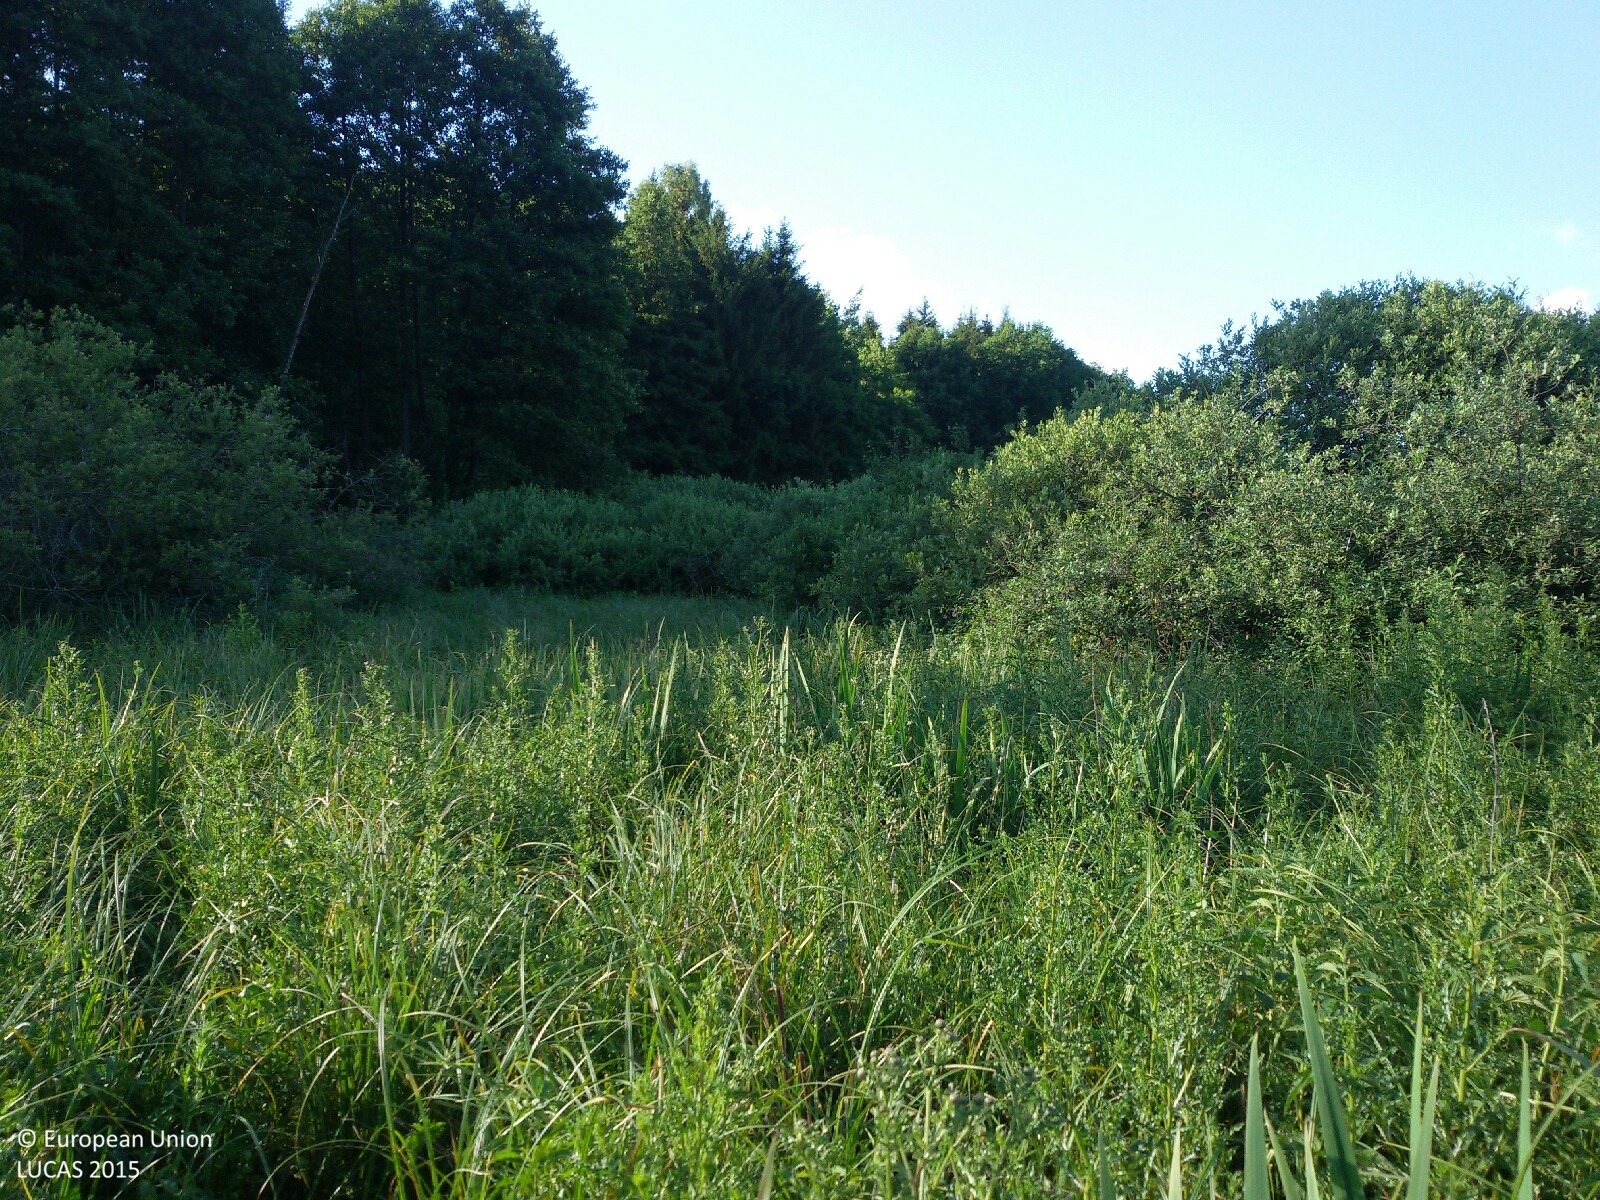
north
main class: Shrubland
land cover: Shrubland without tree cover
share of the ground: 50 - 75 %
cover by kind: shrubs 50 %, herbaceous plants 50 %
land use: Semi-natural and natural areas not in use
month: July
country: PL
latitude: 54.0153
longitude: 20.2742
